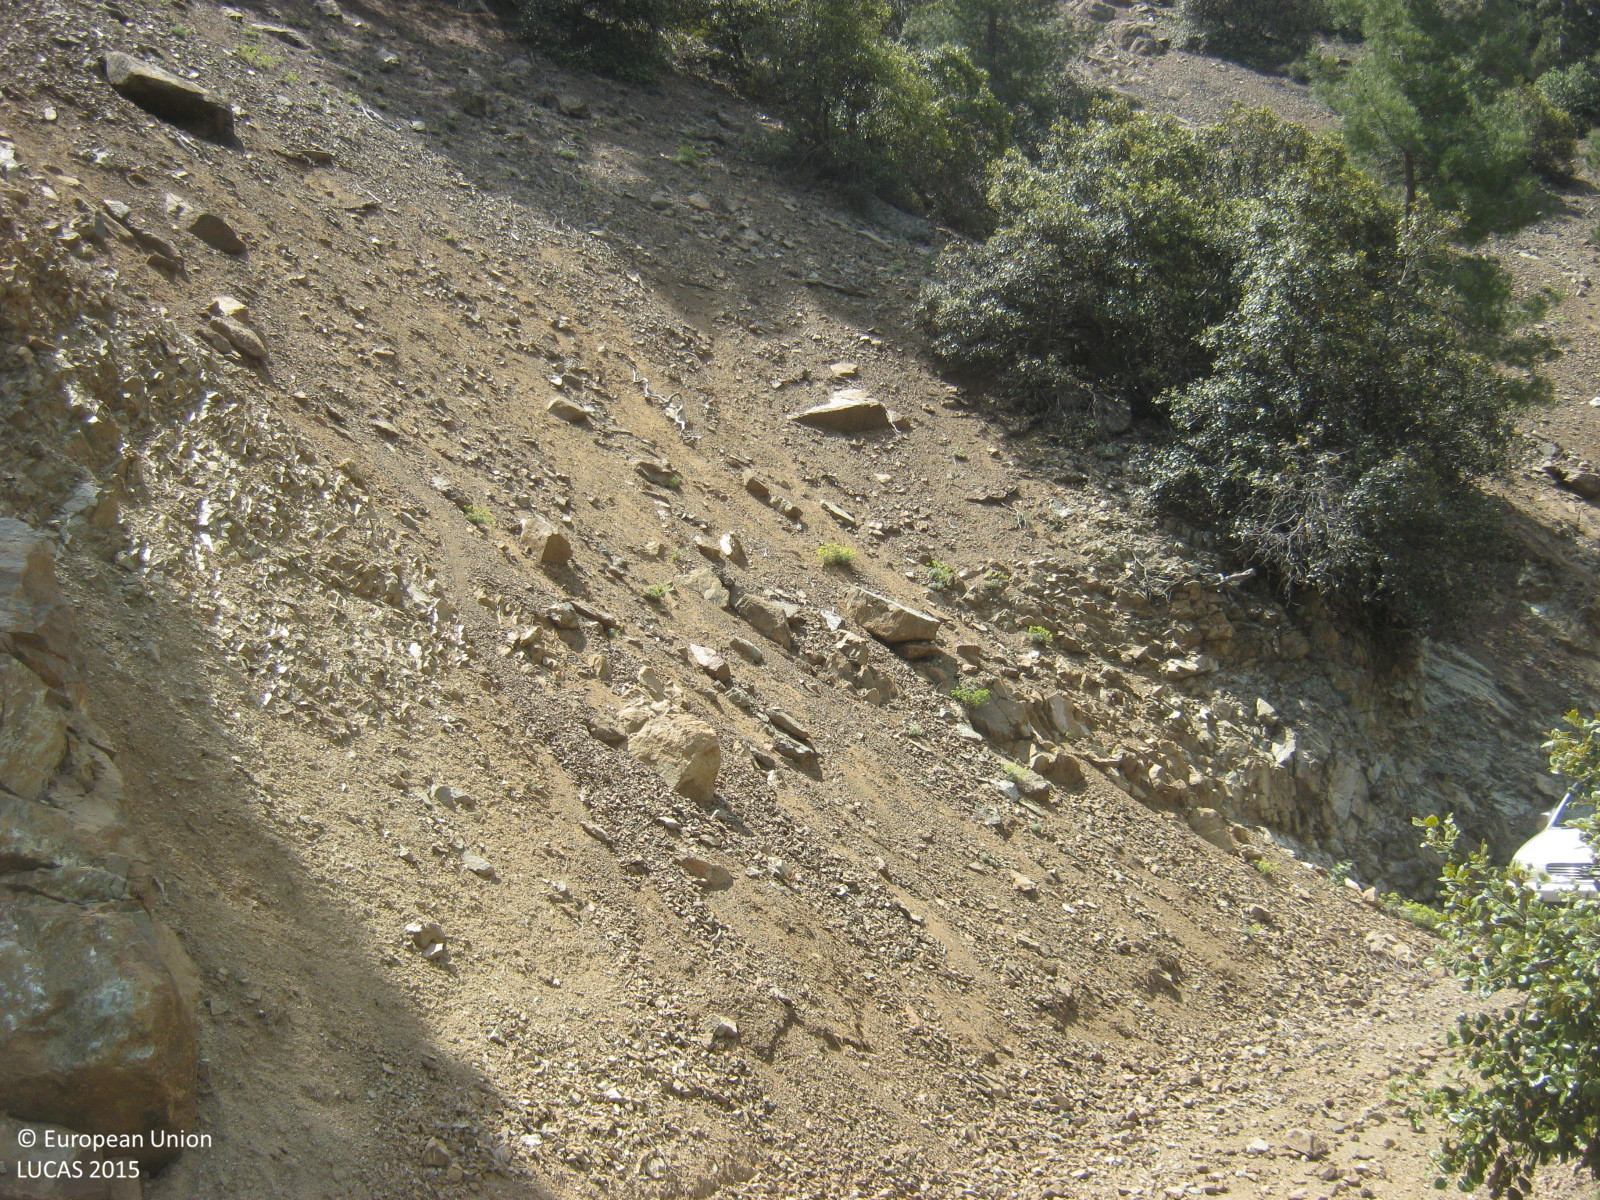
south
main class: Woodland
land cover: Pine dominated coniferous woodland
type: coniferous forest of the mediterranean region
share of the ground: 10 - 25 %
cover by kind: unconsolidated bare surface 65 %, coniferous forest trees 15 %, shrubs 10 %, consolidated bare surface 10 %
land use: Forestry
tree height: > 5 m
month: June
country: CY
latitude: 34.9585
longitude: 32.8693
